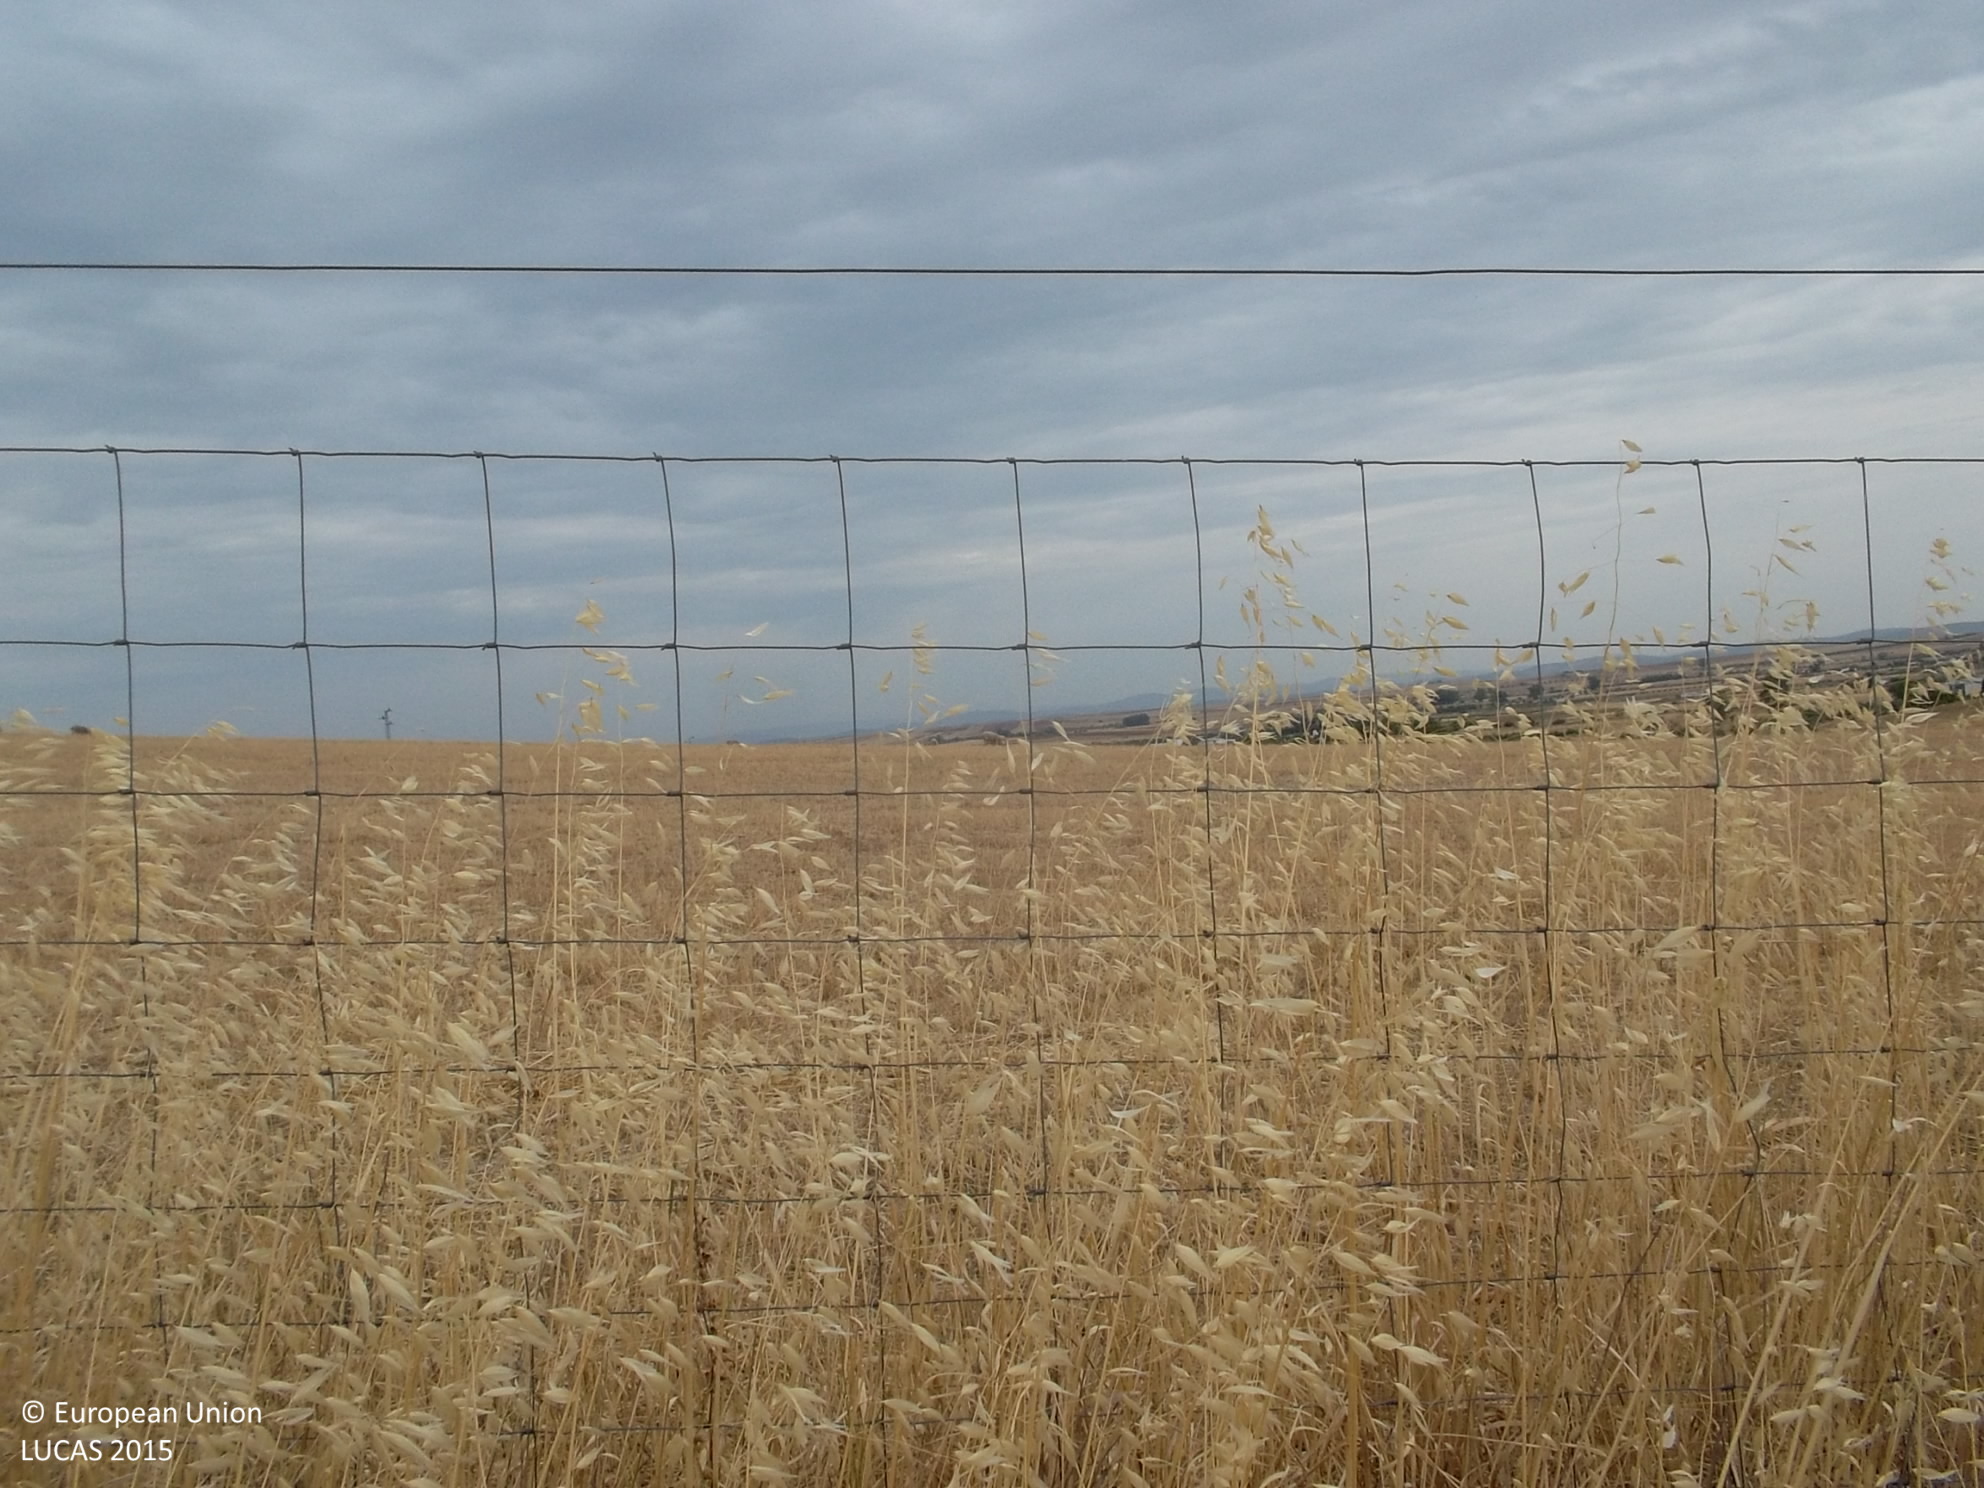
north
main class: Cropland
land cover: Common wheat
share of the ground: < 10 %
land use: Agriculture (excluding fallow land and kitchen gardens)
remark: Harvested field
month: July
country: ES
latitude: 38.5123
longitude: -5.1569
